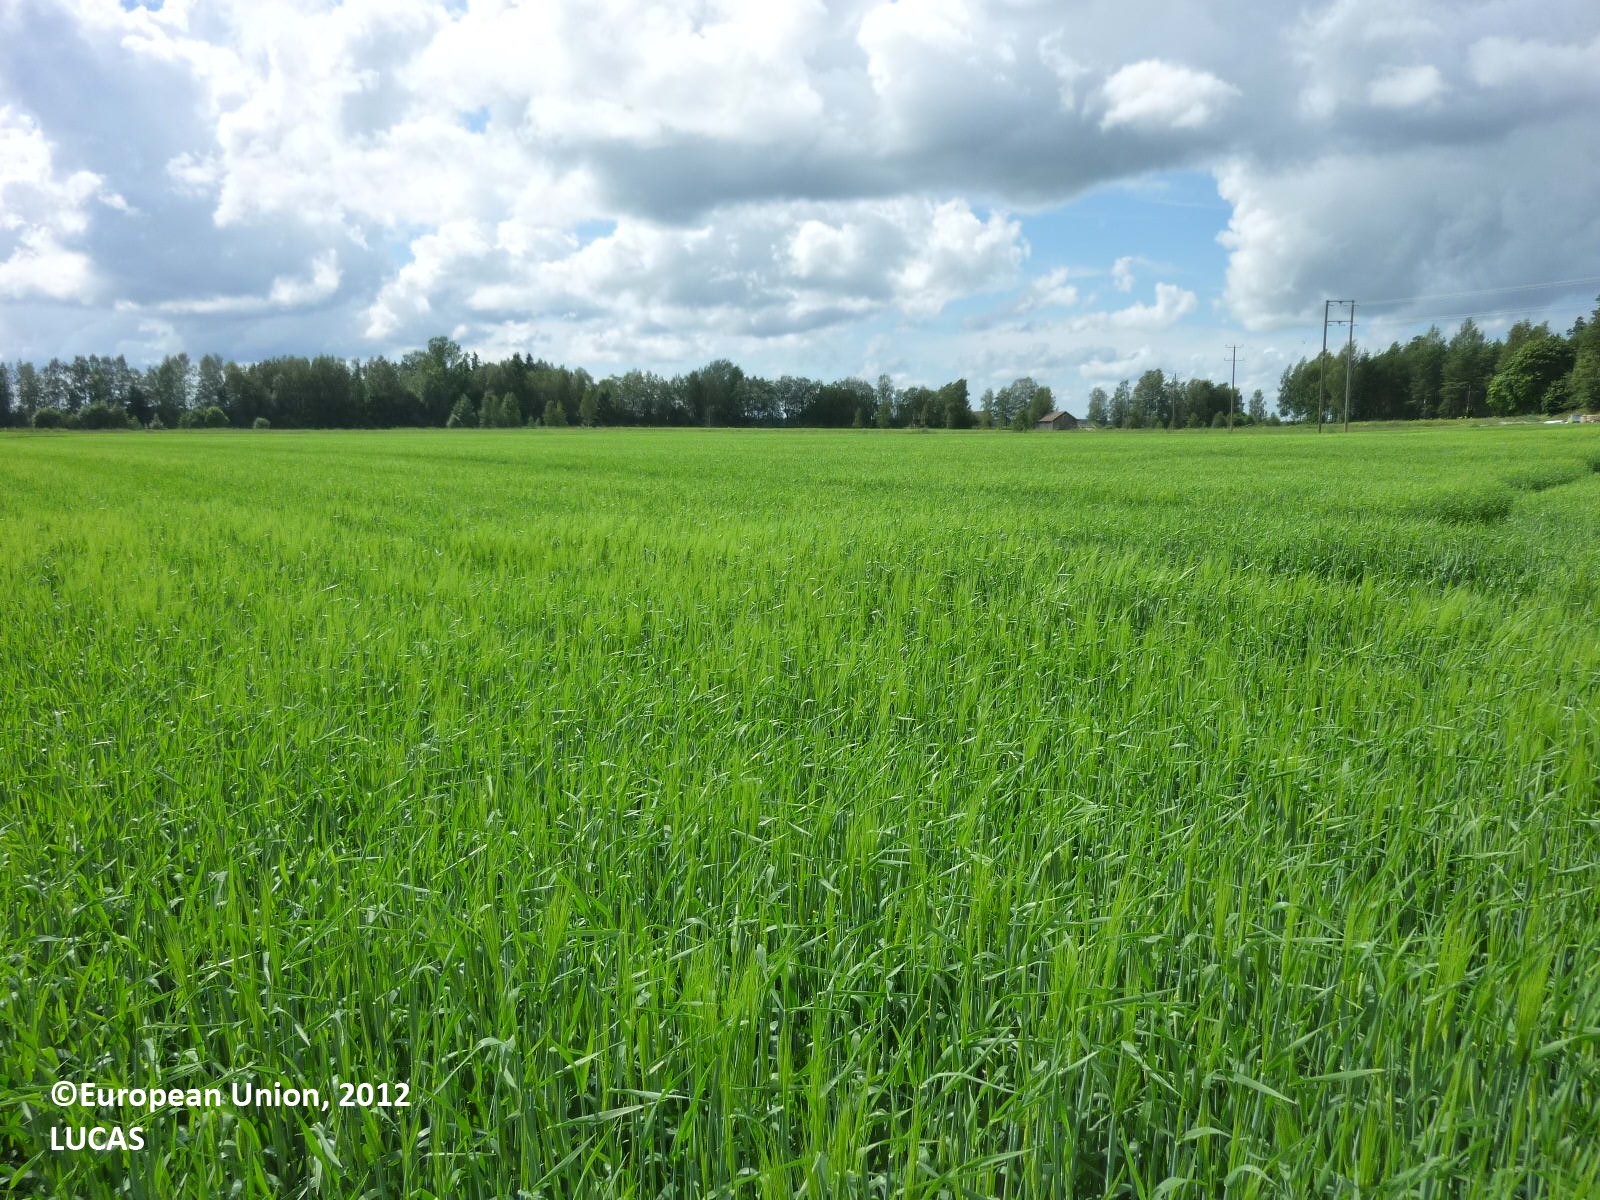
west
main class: Cropland
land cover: Barley
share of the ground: > 75 %
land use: Agriculture (excluding fallow land and kitchen gardens)
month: July
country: FI
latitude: 61.2239
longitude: 21.9196
